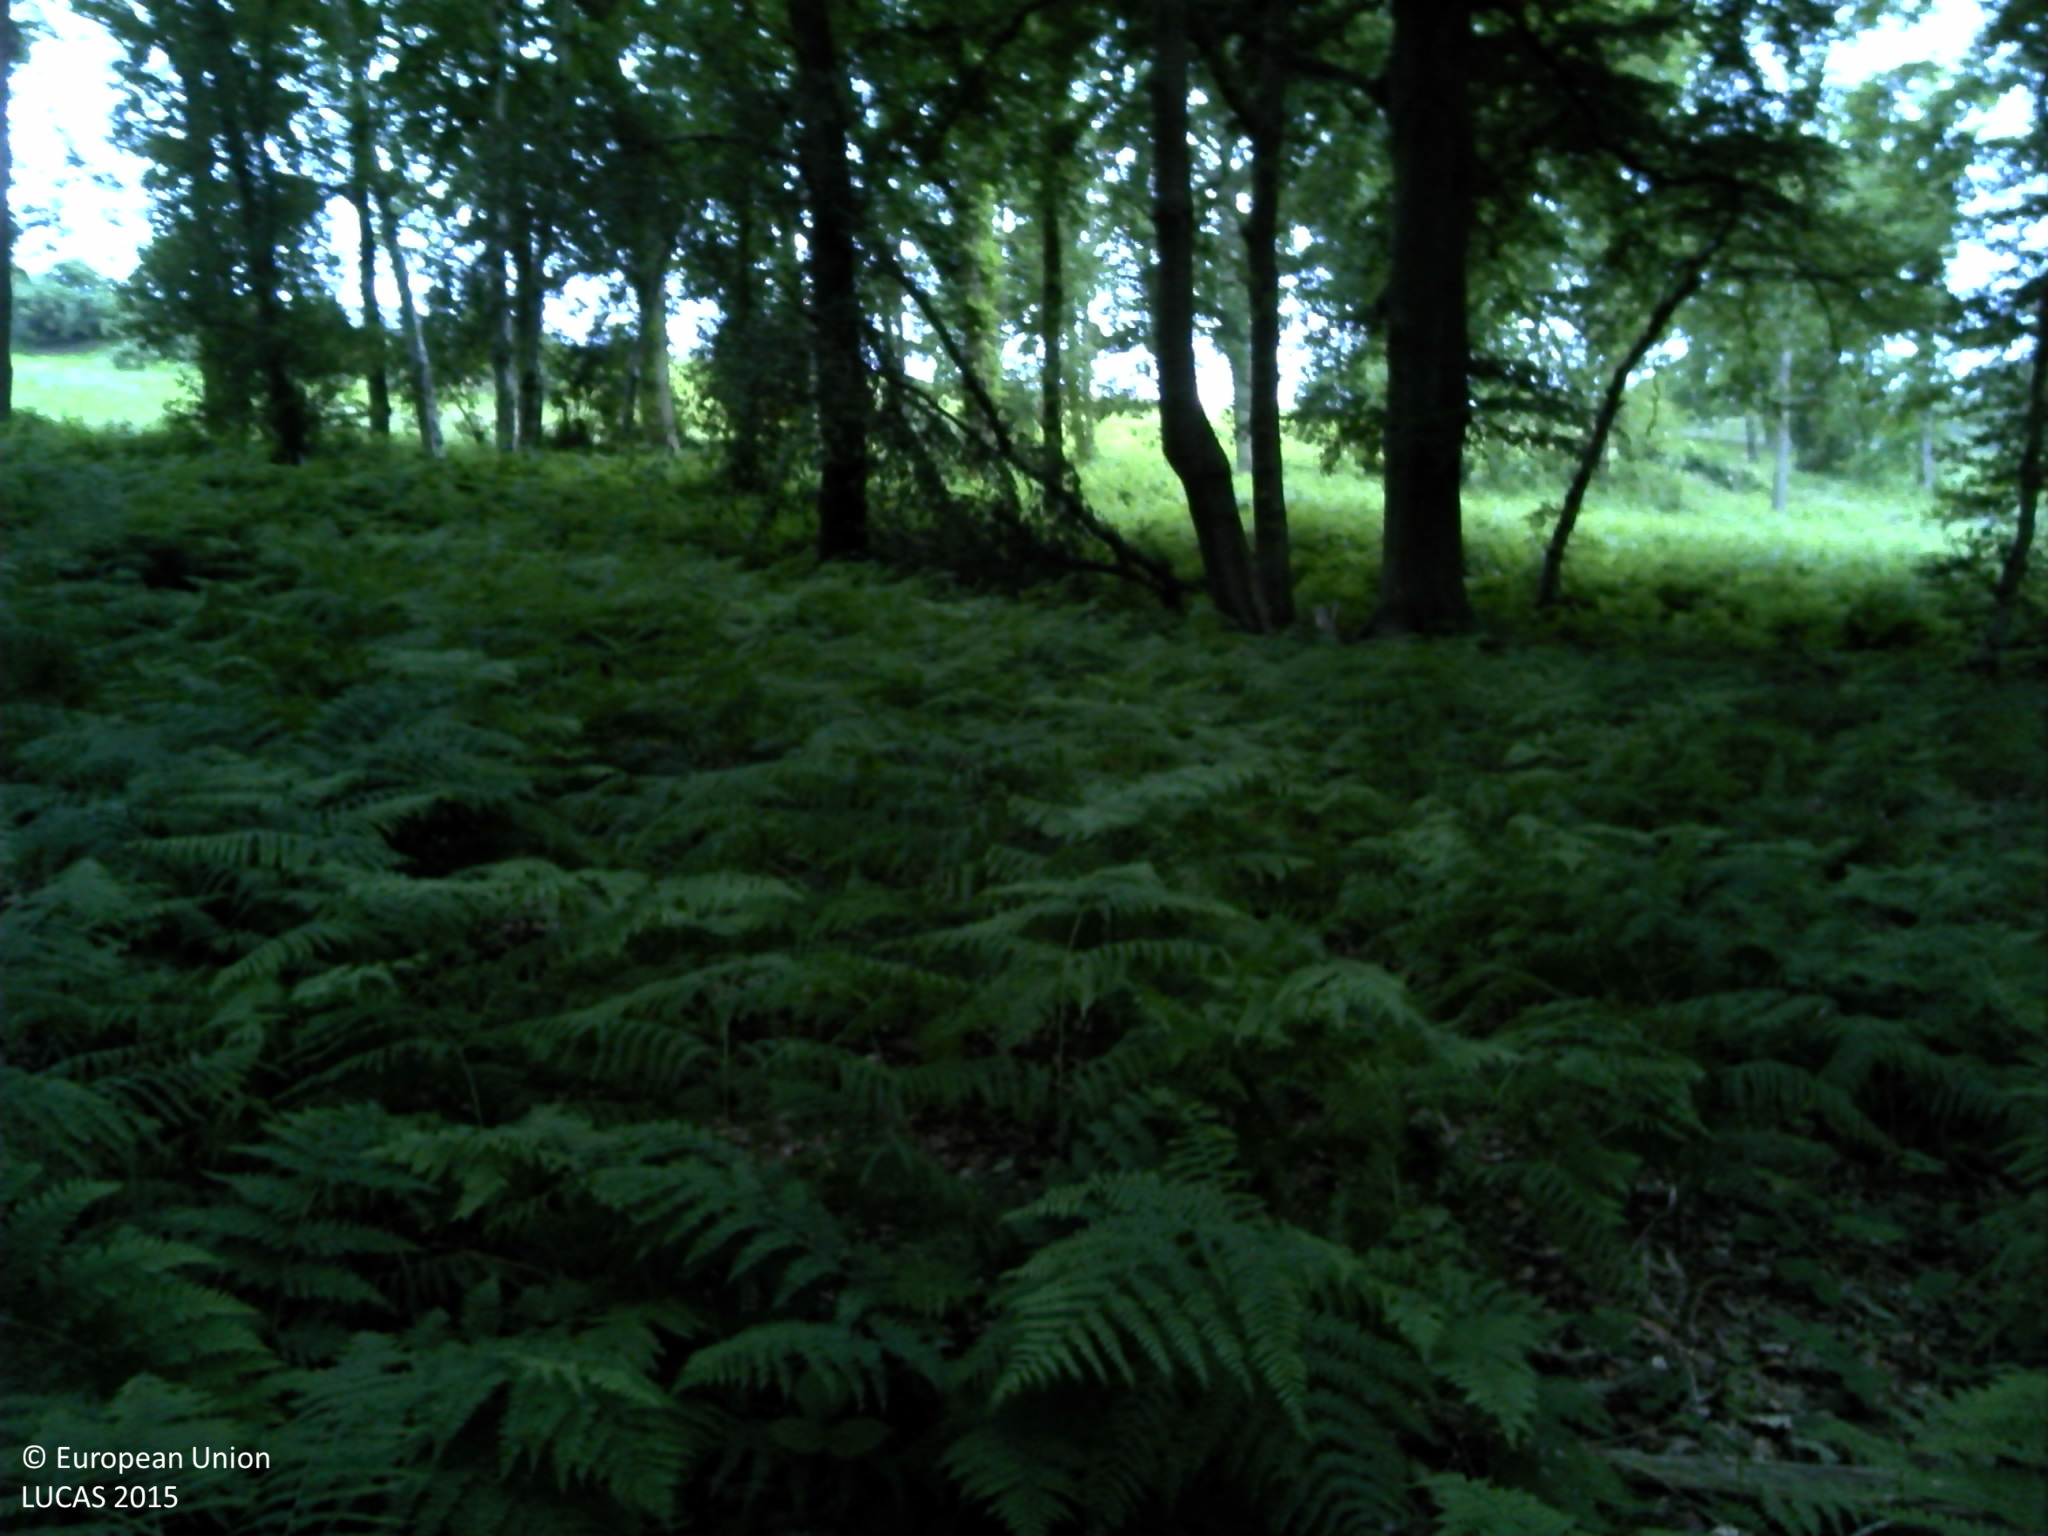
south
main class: Woodland
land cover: Broadleaved woodland
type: acidophilous oak and oak-birch forest
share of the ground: > 75 %
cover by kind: broadleaved forest trees 95 %, herbaceous plants 5 %
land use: Forestry
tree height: > 5 m
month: June
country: FR
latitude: 49.6778
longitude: 0.2840
